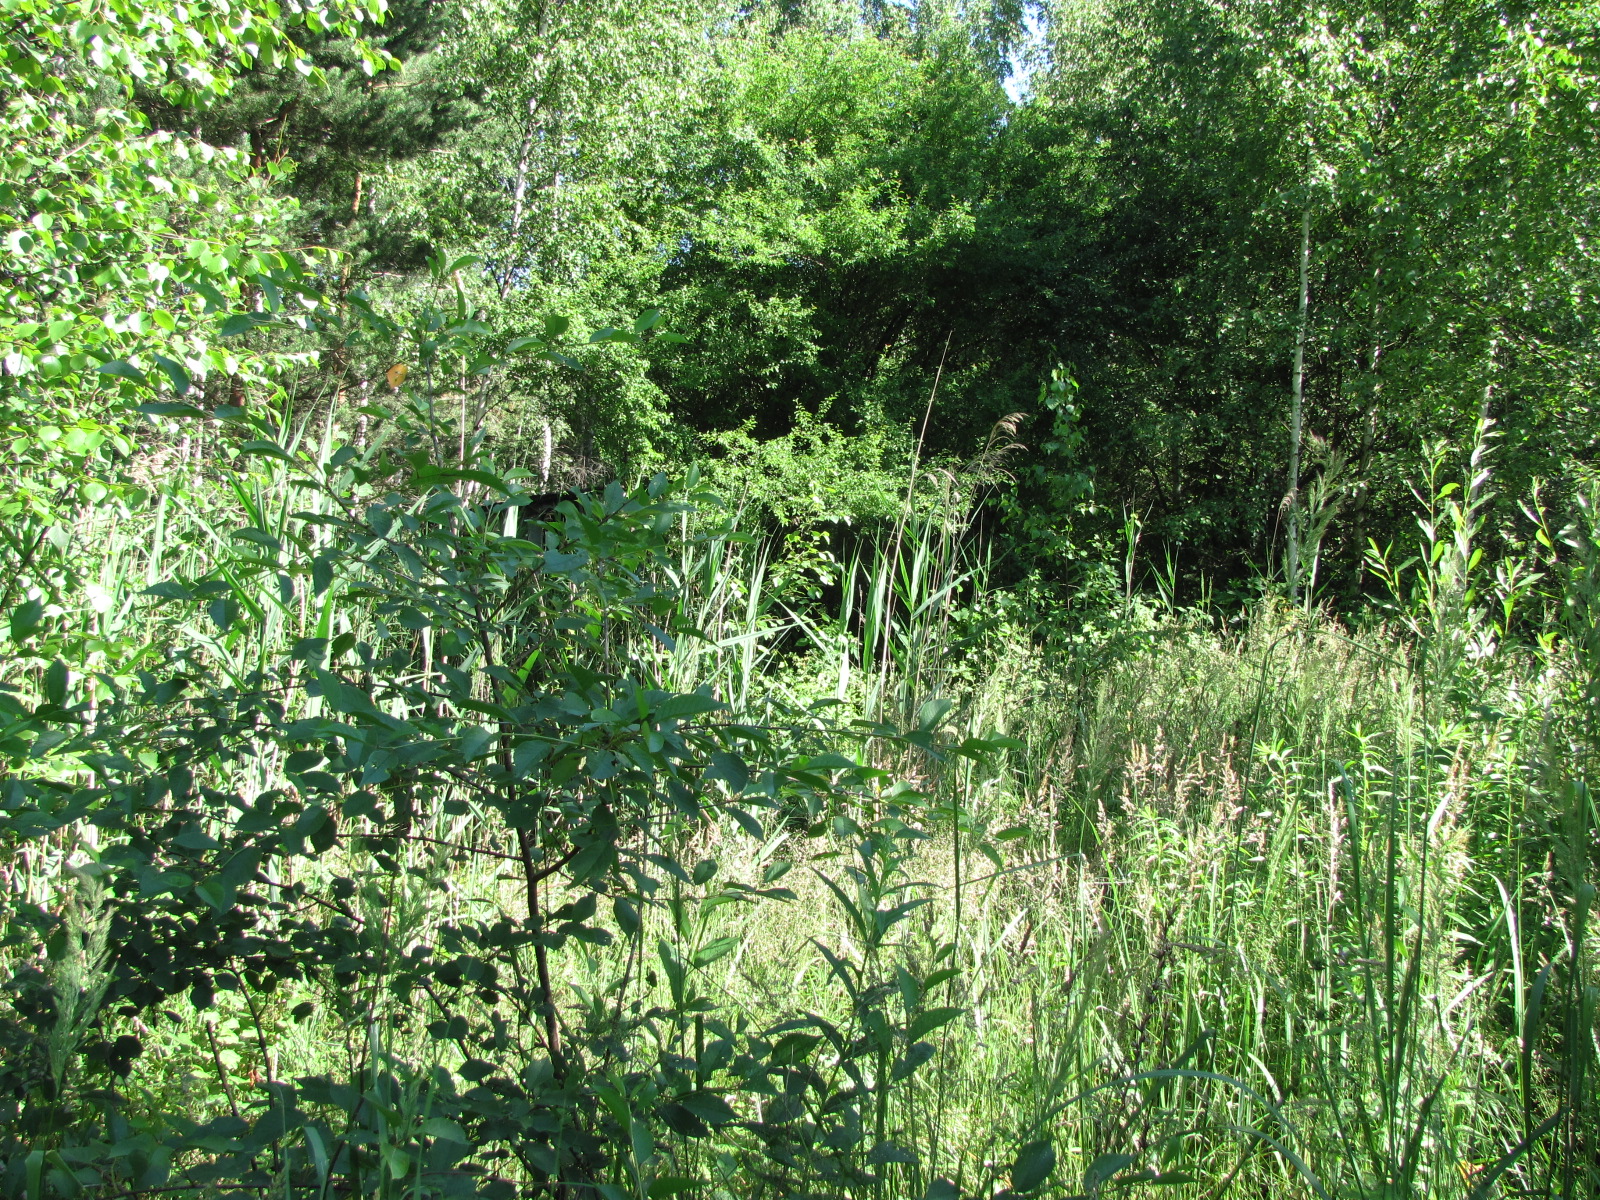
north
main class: Woodland
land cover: Broadleaved woodland
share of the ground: 25 - 50 %
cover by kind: herbaceous plants 55 %, broadleaved forest trees 45 %
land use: Abandoned areas
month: July
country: LV
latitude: 56.8622
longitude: 24.1431
